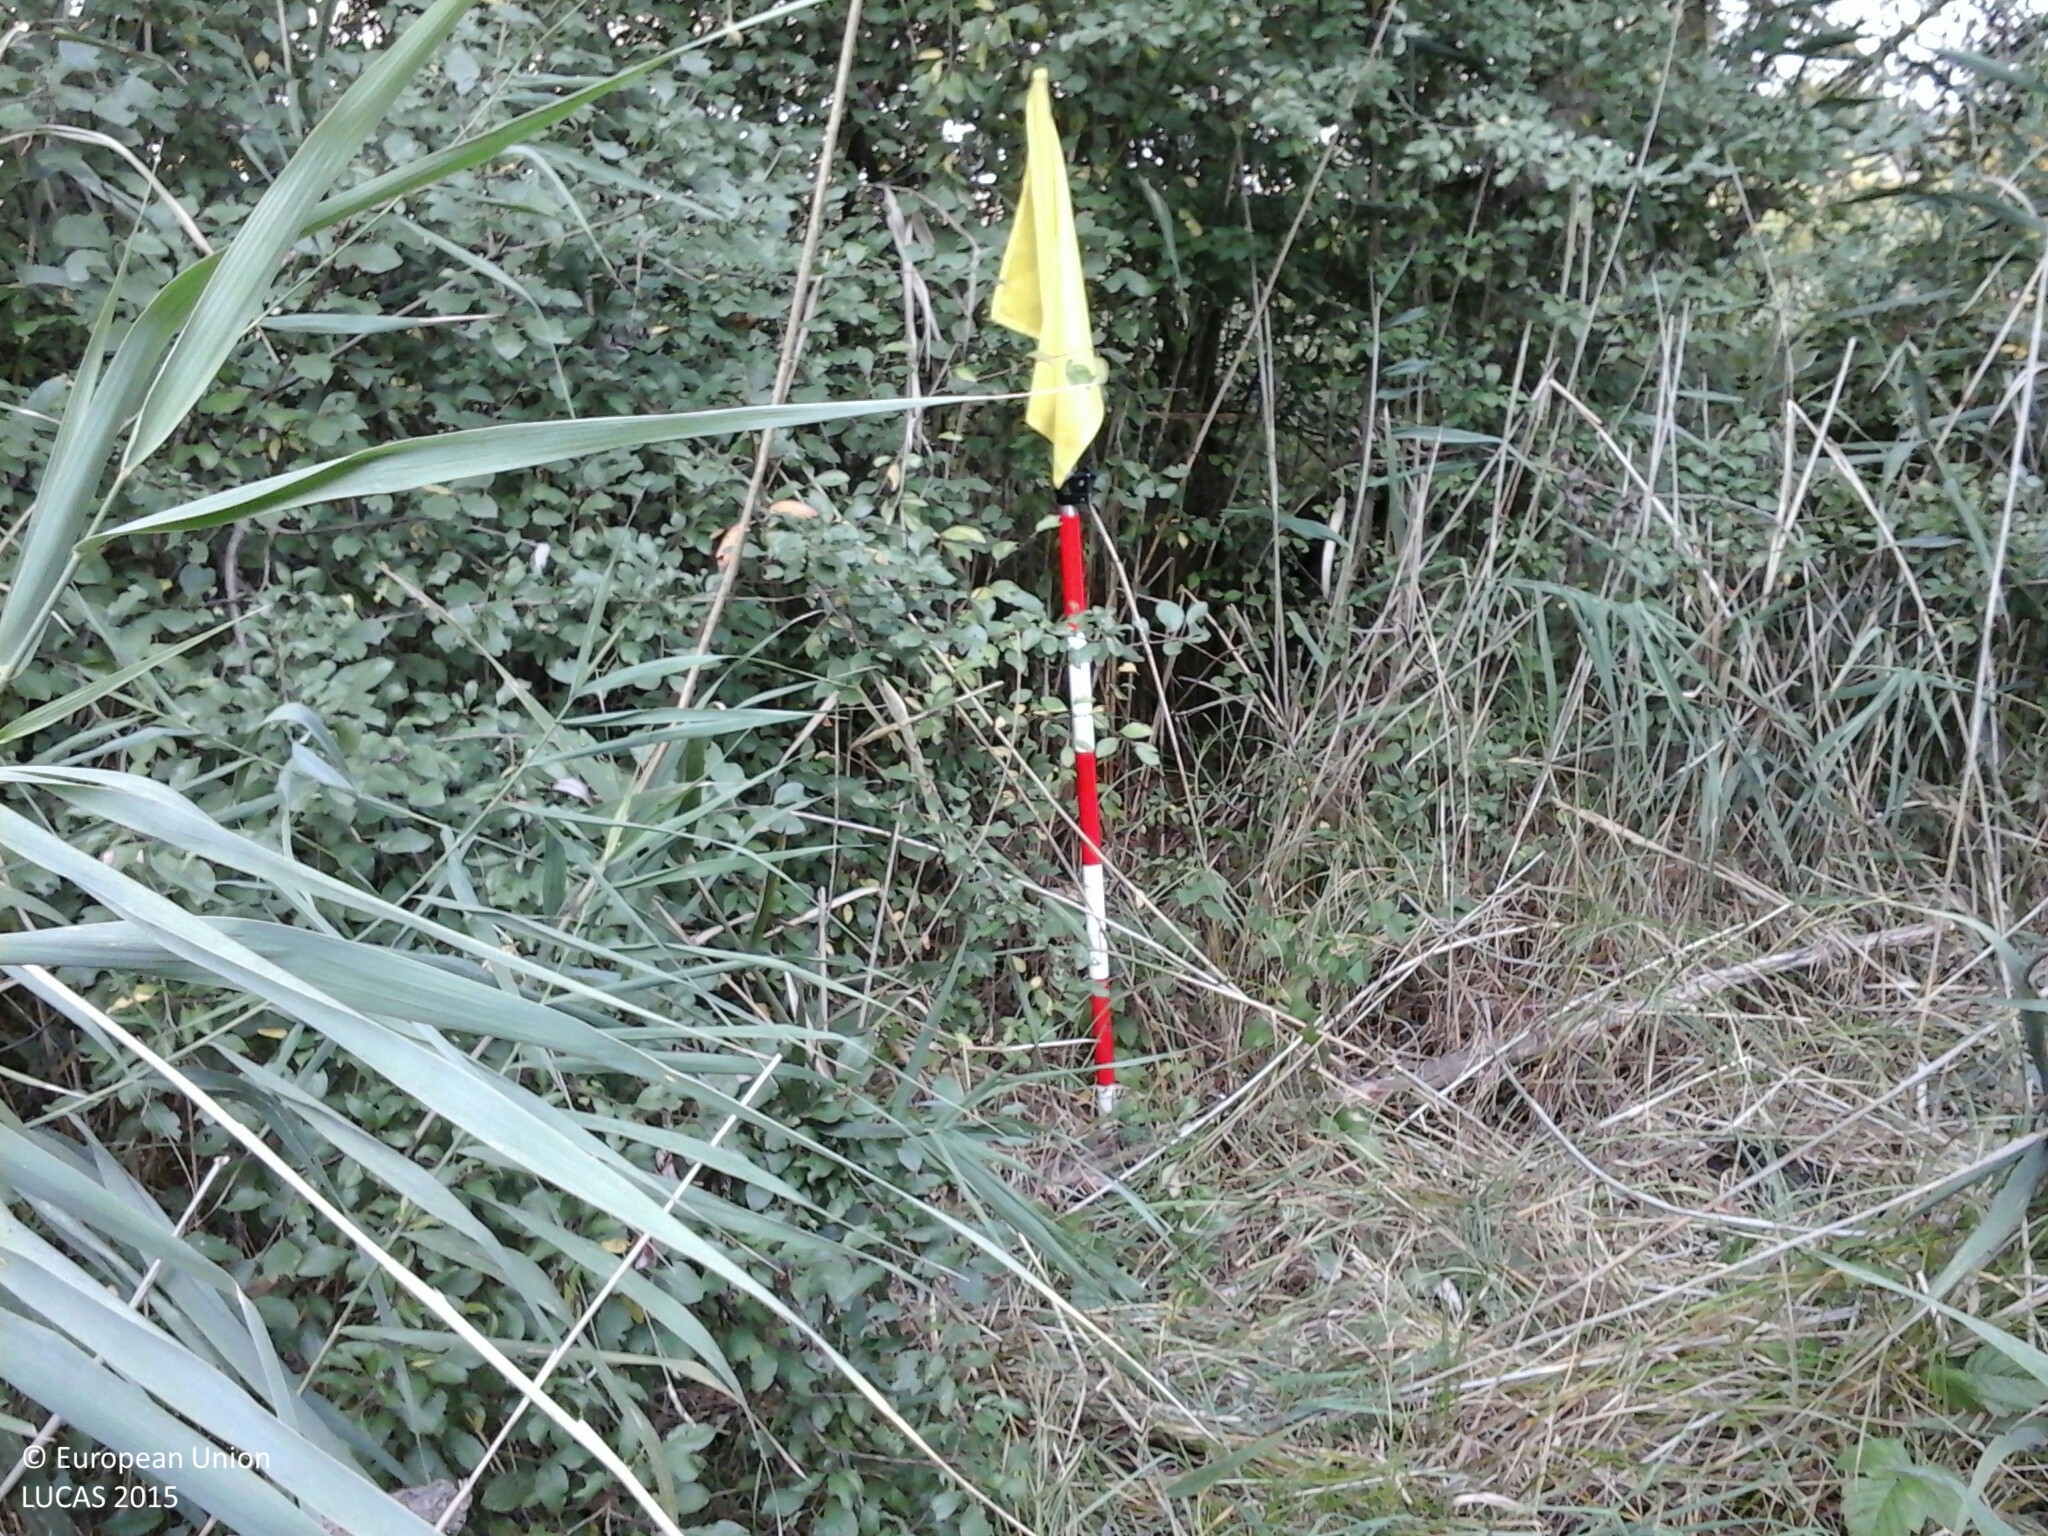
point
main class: Grassland
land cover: Grassland with sparse tree/shrub cover
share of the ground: > 75 %
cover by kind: herbaceous plants 85 %, shrubs 10 %, broadleaved forest trees 5 %
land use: Semi-natural and natural areas not in use
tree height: > 5 m
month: September
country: HU
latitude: 47.9835
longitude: 19.8203
